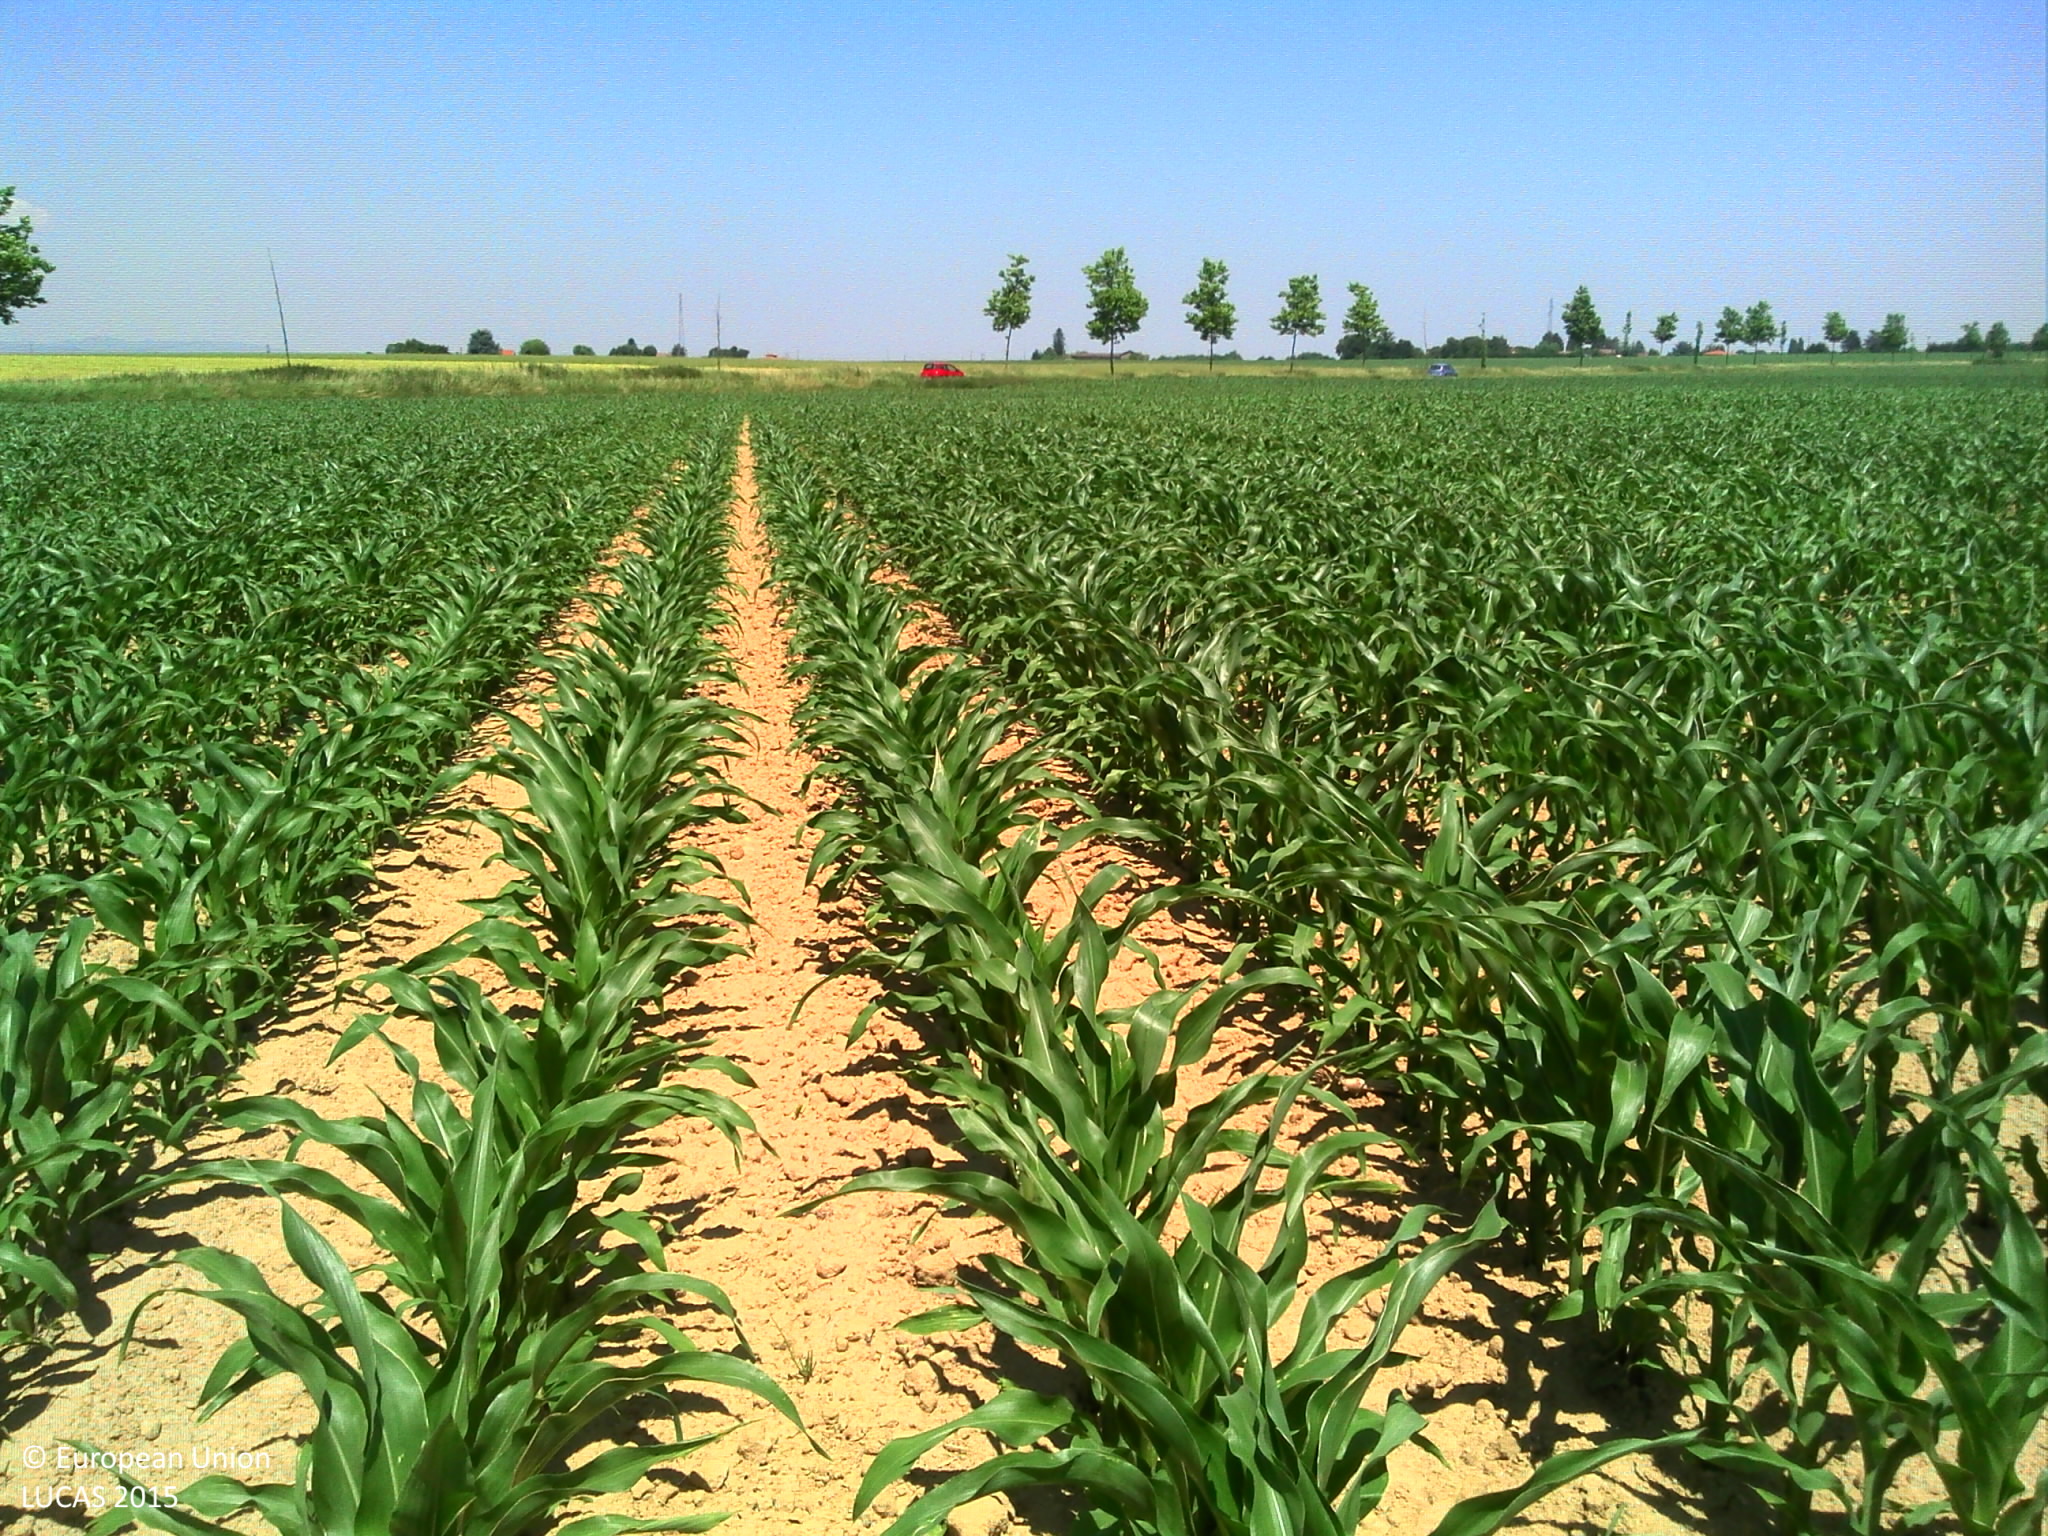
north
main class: Cropland
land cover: Maize
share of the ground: 10 - 25 %
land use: Agriculture (excluding fallow land and kitchen gardens)
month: June
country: FR
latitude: 46.0093
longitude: 4.8242
